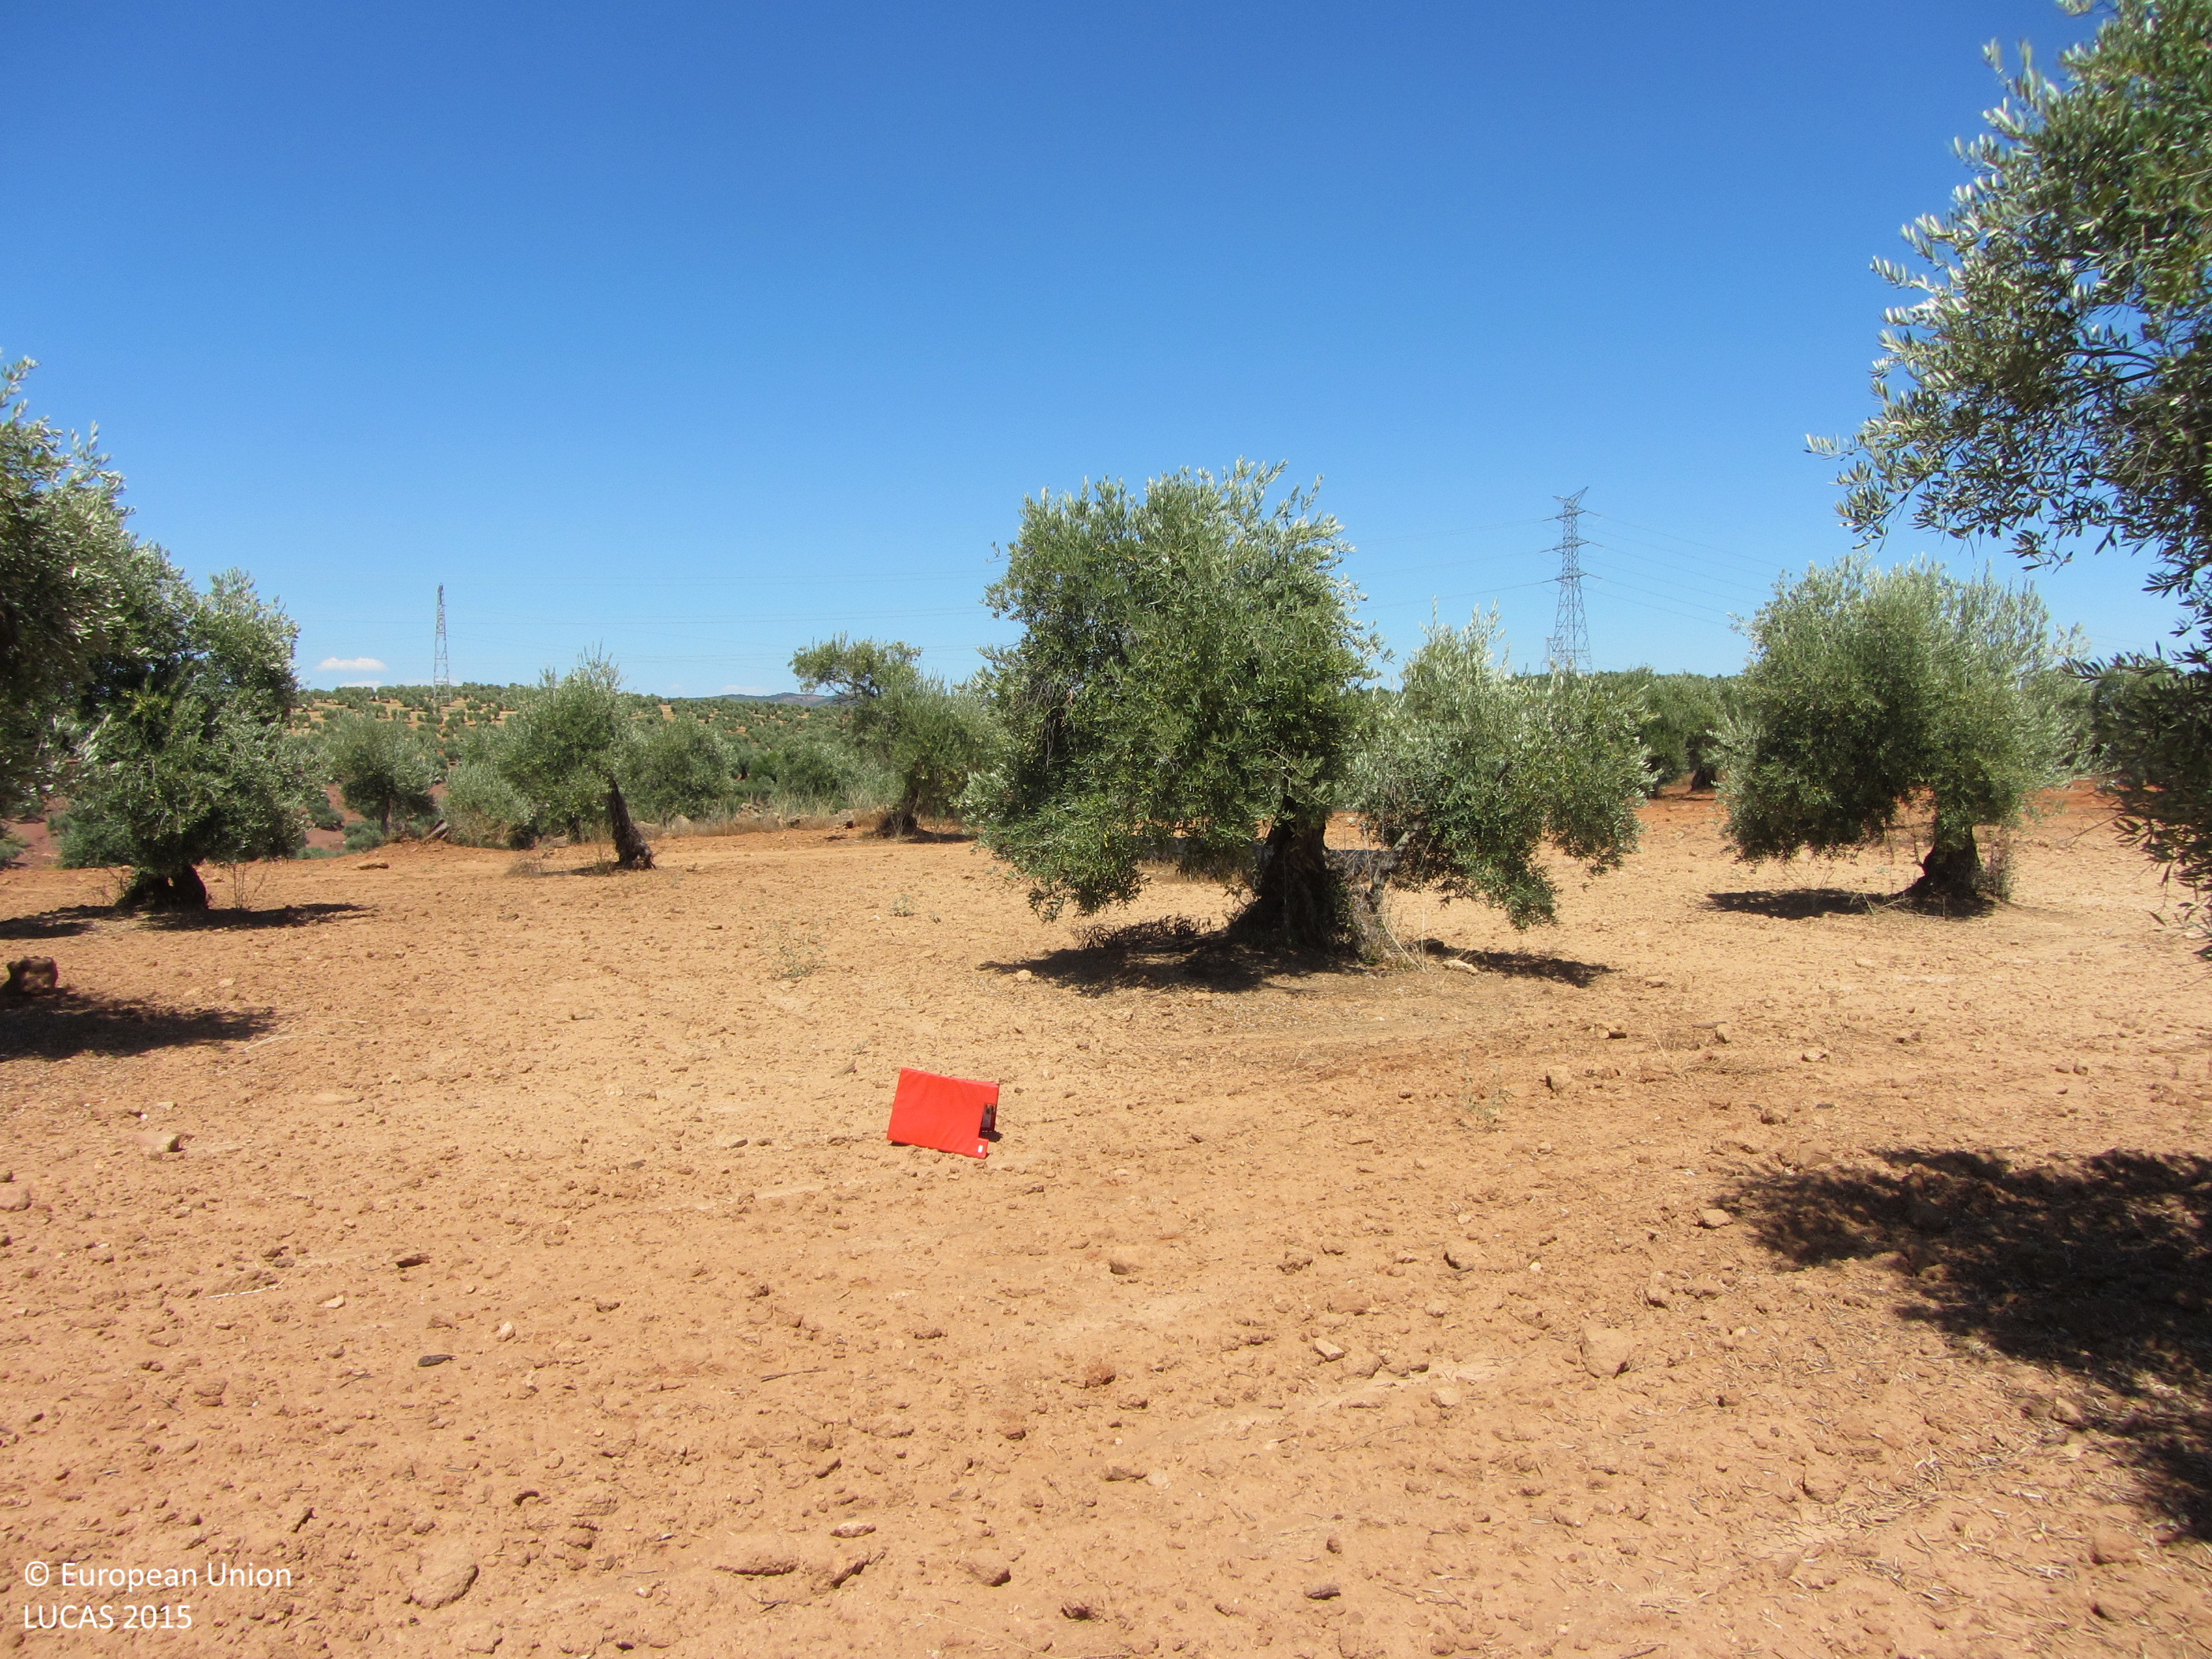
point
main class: Cropland
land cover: Olive groves
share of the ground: 25 - 50 %
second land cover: Other bare soil
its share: > 75 %
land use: Agriculture (excluding fallow land and kitchen gardens)
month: July
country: ES
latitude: 38.0688
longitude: -4.2244
